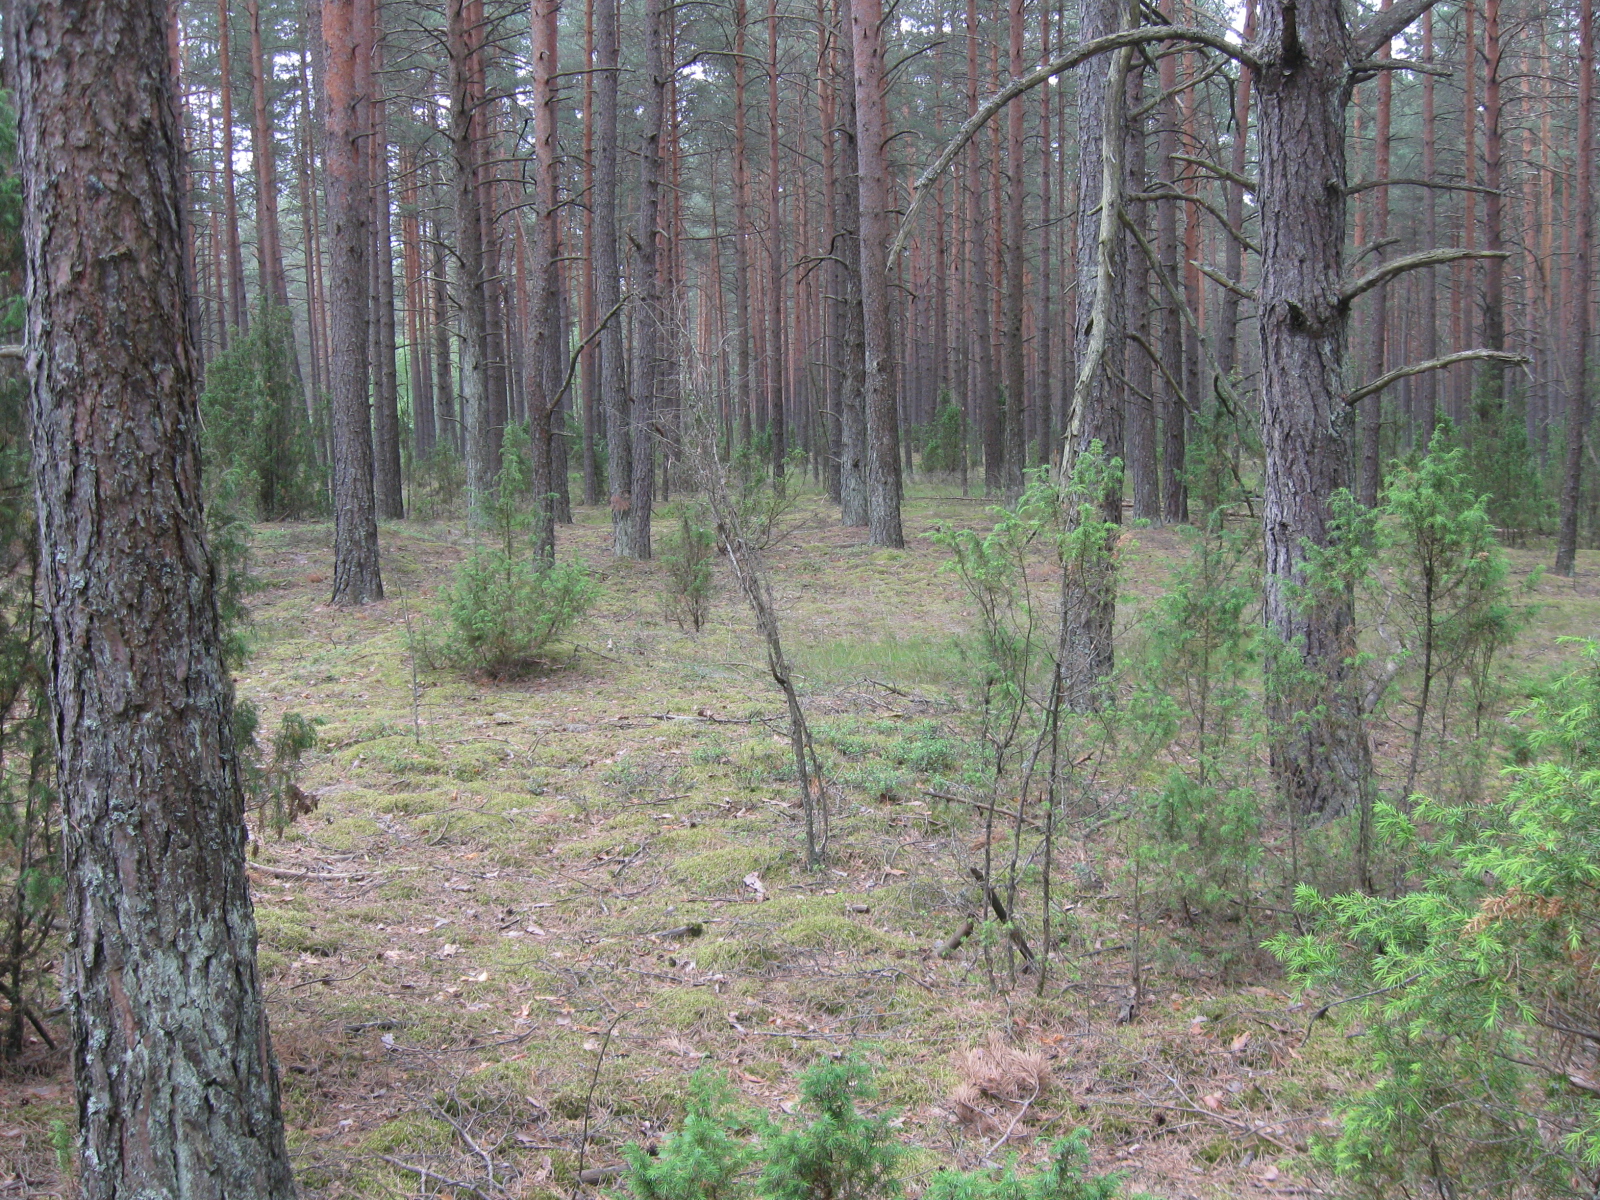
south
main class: Woodland
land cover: Pine dominated coniferous woodland
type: hemiboreal forest and nemoral coniferous forest and mixed broadleaved-coniferous forest
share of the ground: > 75 %
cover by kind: coniferous forest trees 95 %, lichens and mosses 5 %
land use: Forestry
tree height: > 5 m
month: July
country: LT
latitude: 54.1775
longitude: 24.2704
